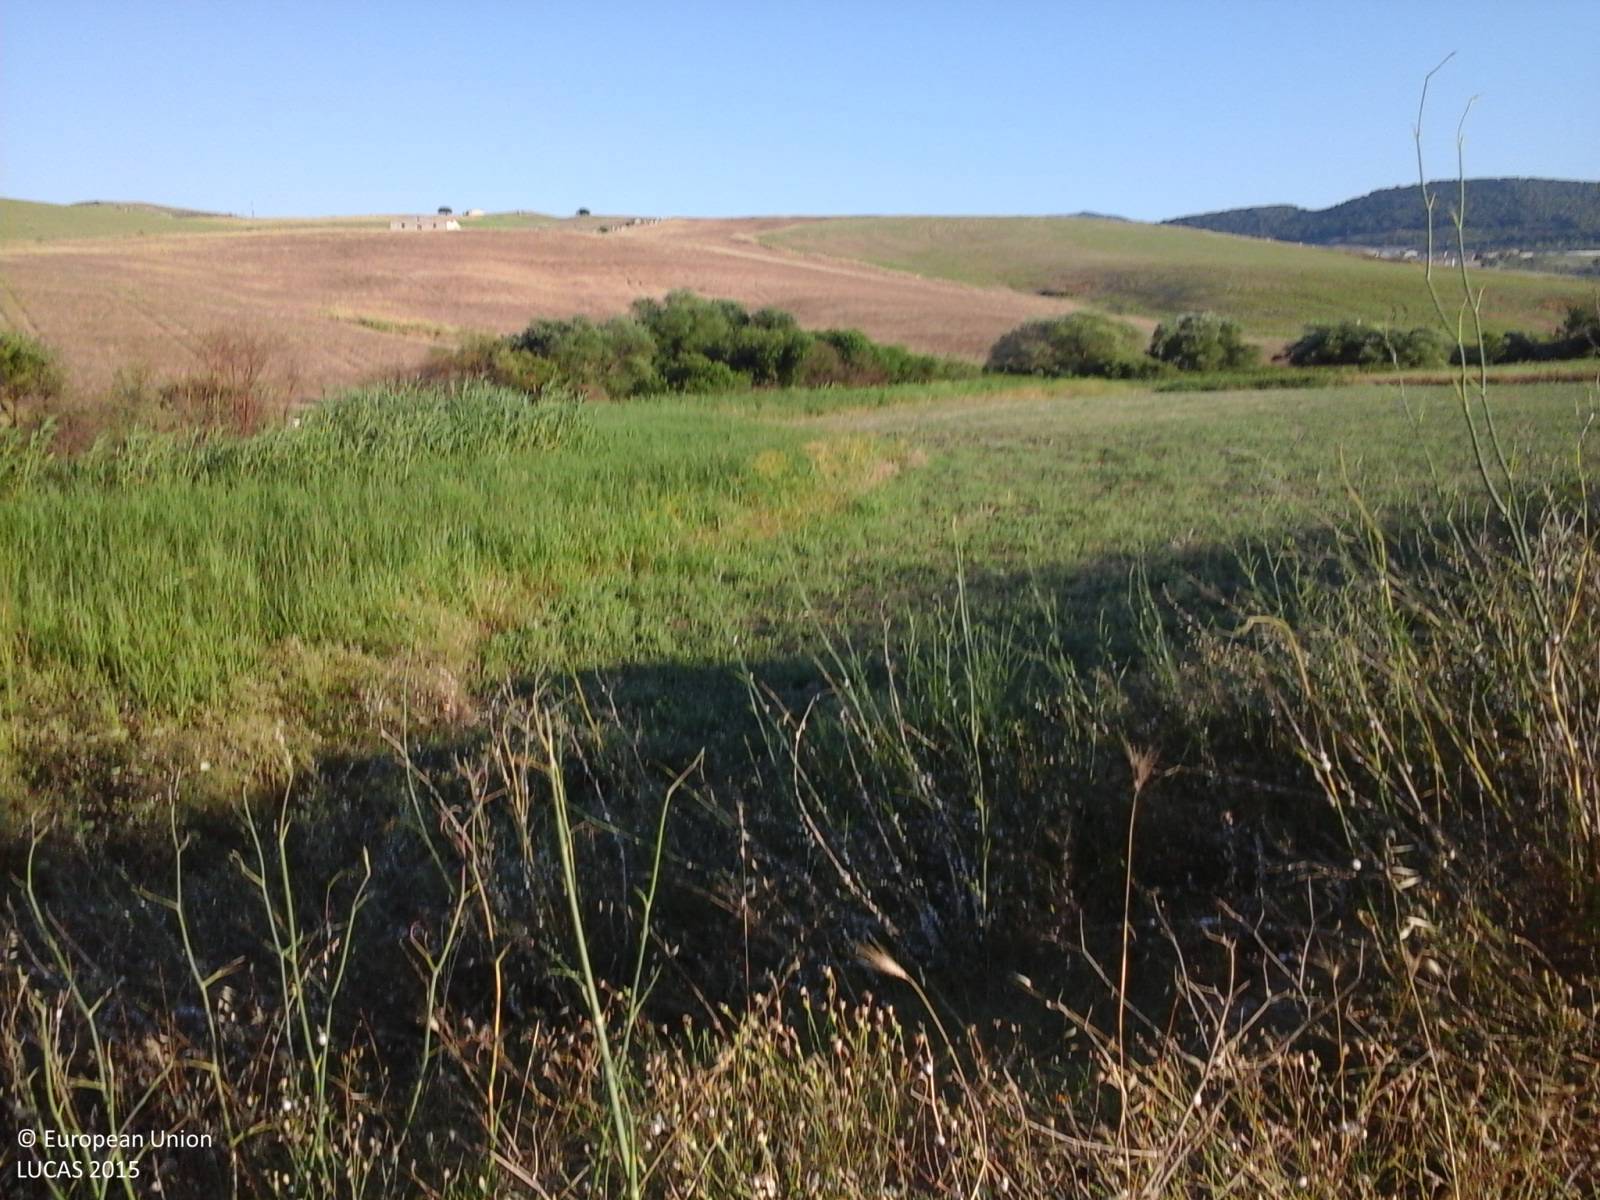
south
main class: Cropland
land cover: Durum wheat
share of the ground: > 75 %
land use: Agriculture (excluding fallow land and kitchen gardens)
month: July
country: IT
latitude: 37.7486
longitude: 13.1882
